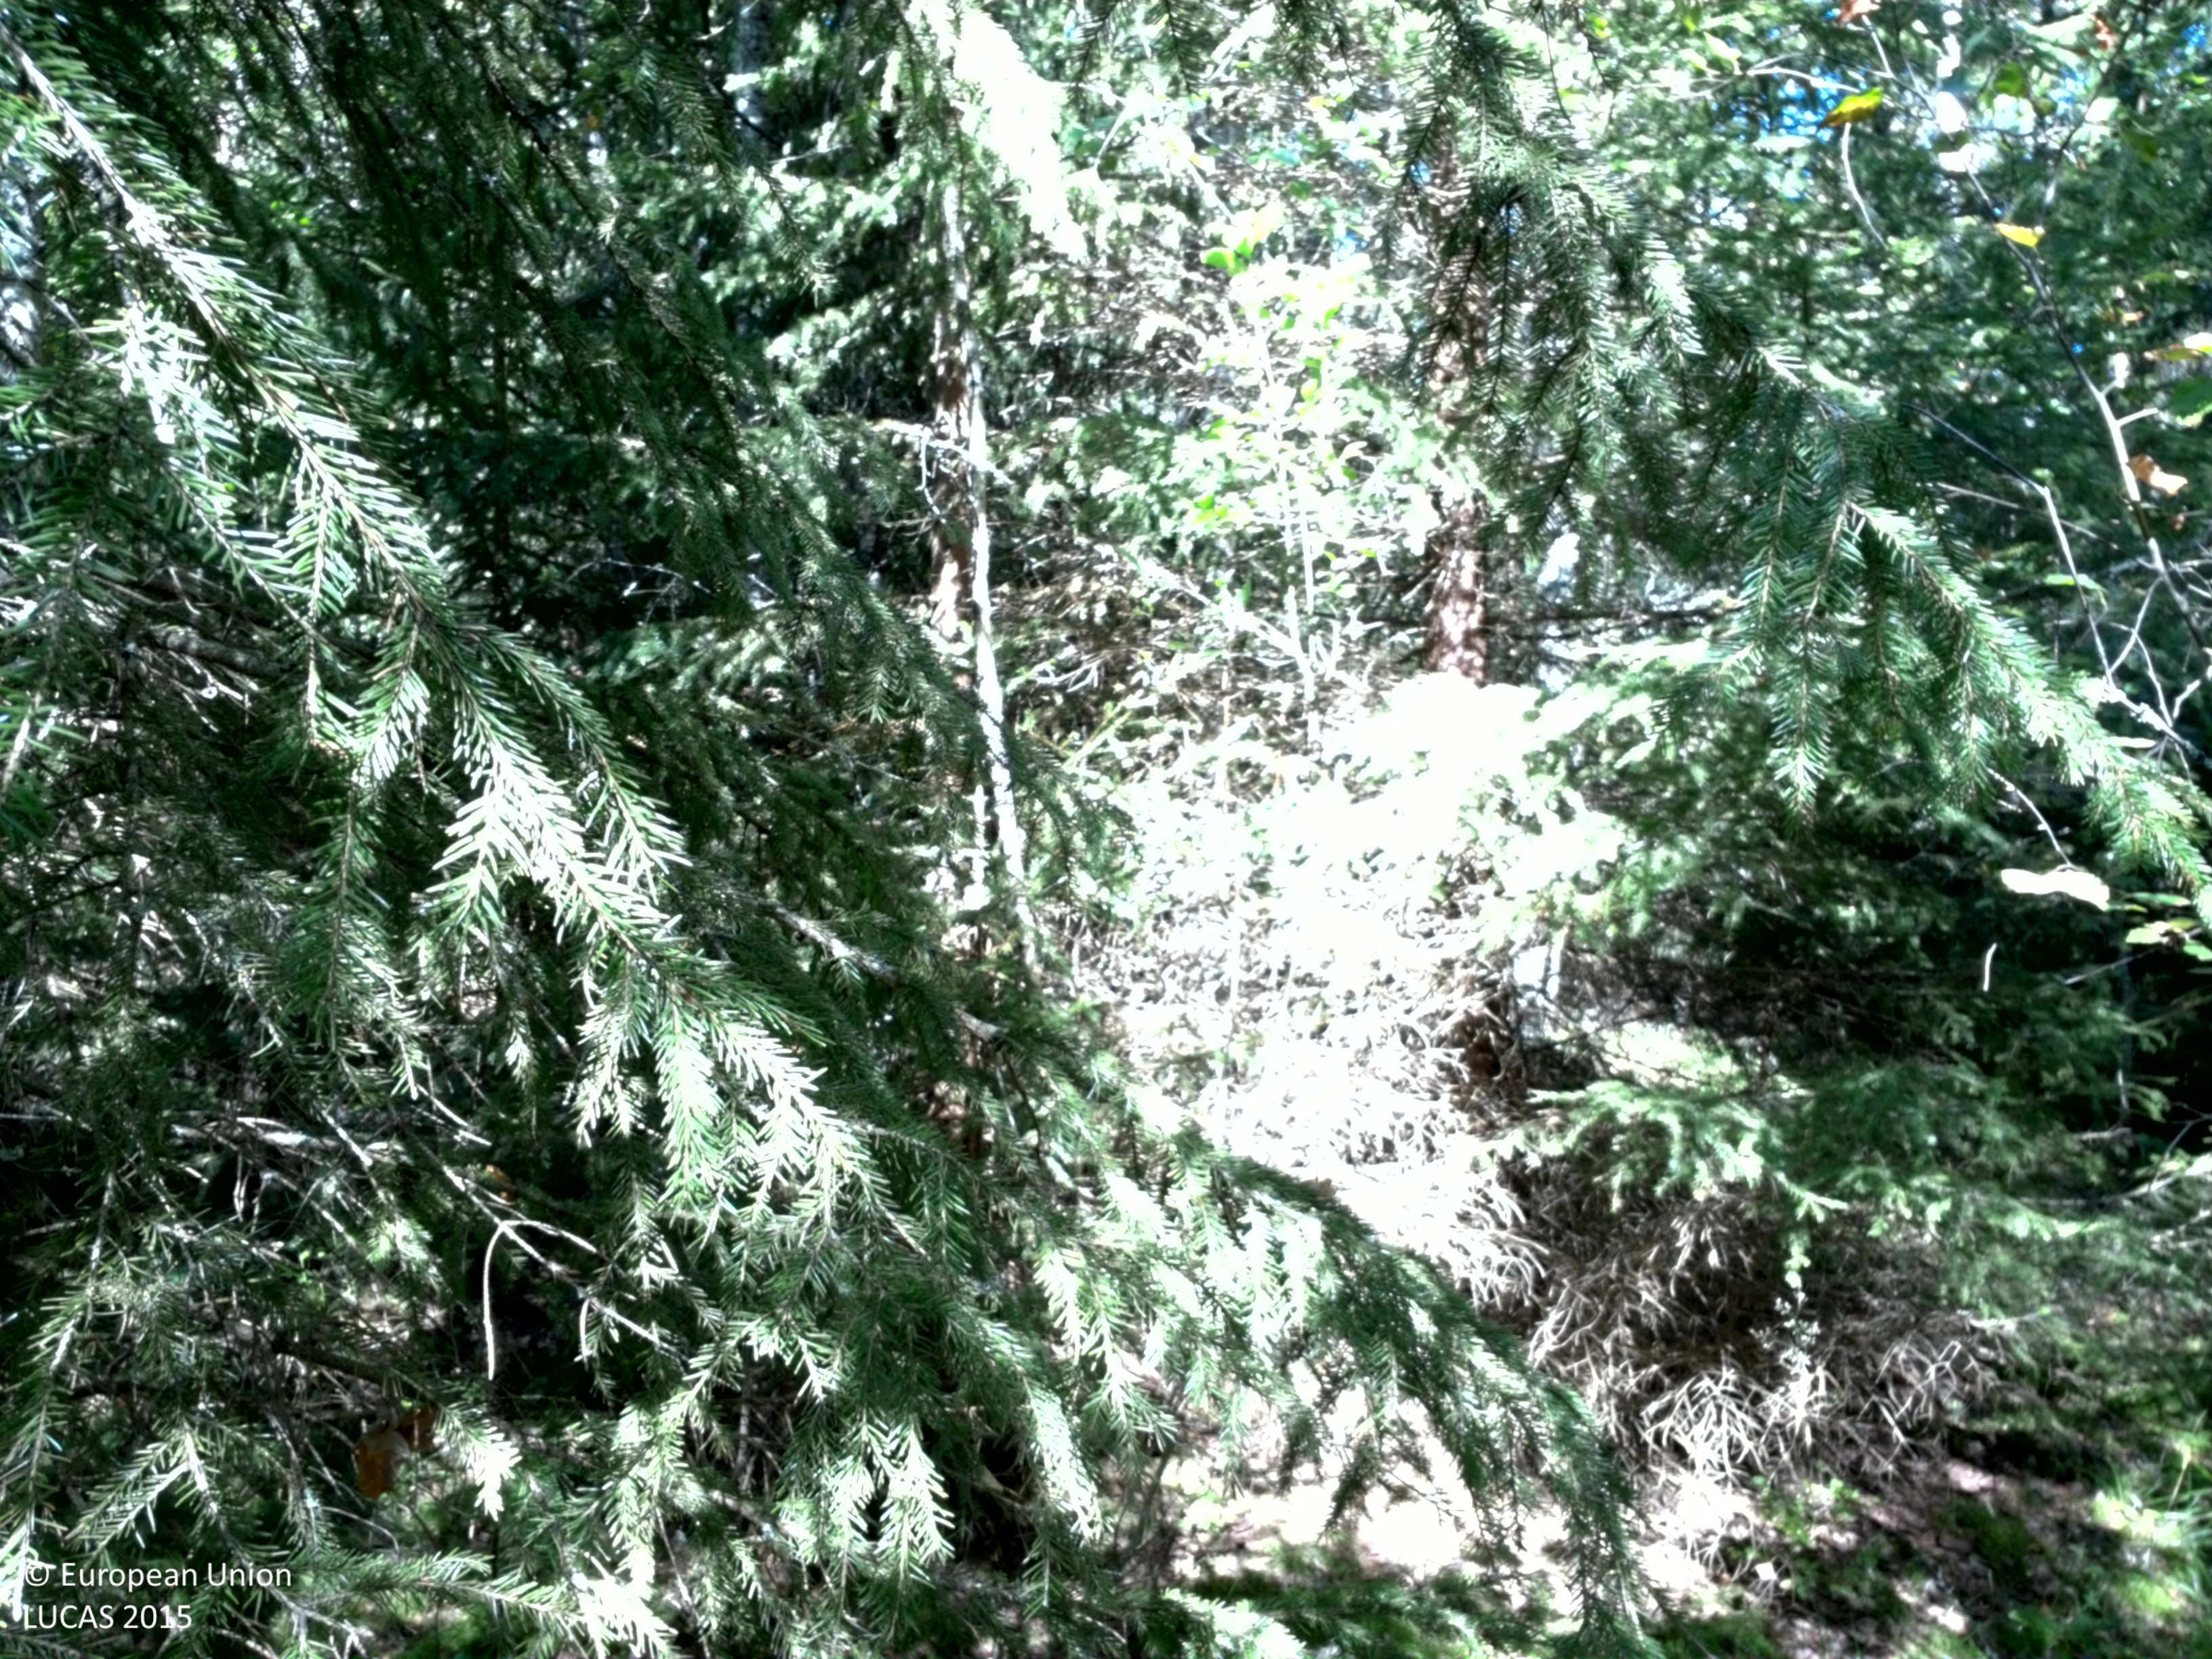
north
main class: Woodland
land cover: Spruce dominated mixed woodland
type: boreal forest
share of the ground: > 75 %
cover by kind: coniferous forest trees 65 %, broadleaved forest trees 25 %, herbaceous plants 5 %, lichens and mosses 5 %
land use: Forestry
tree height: > 5 m
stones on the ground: < 10 %
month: August
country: SE
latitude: 59.8040
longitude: 16.7118
